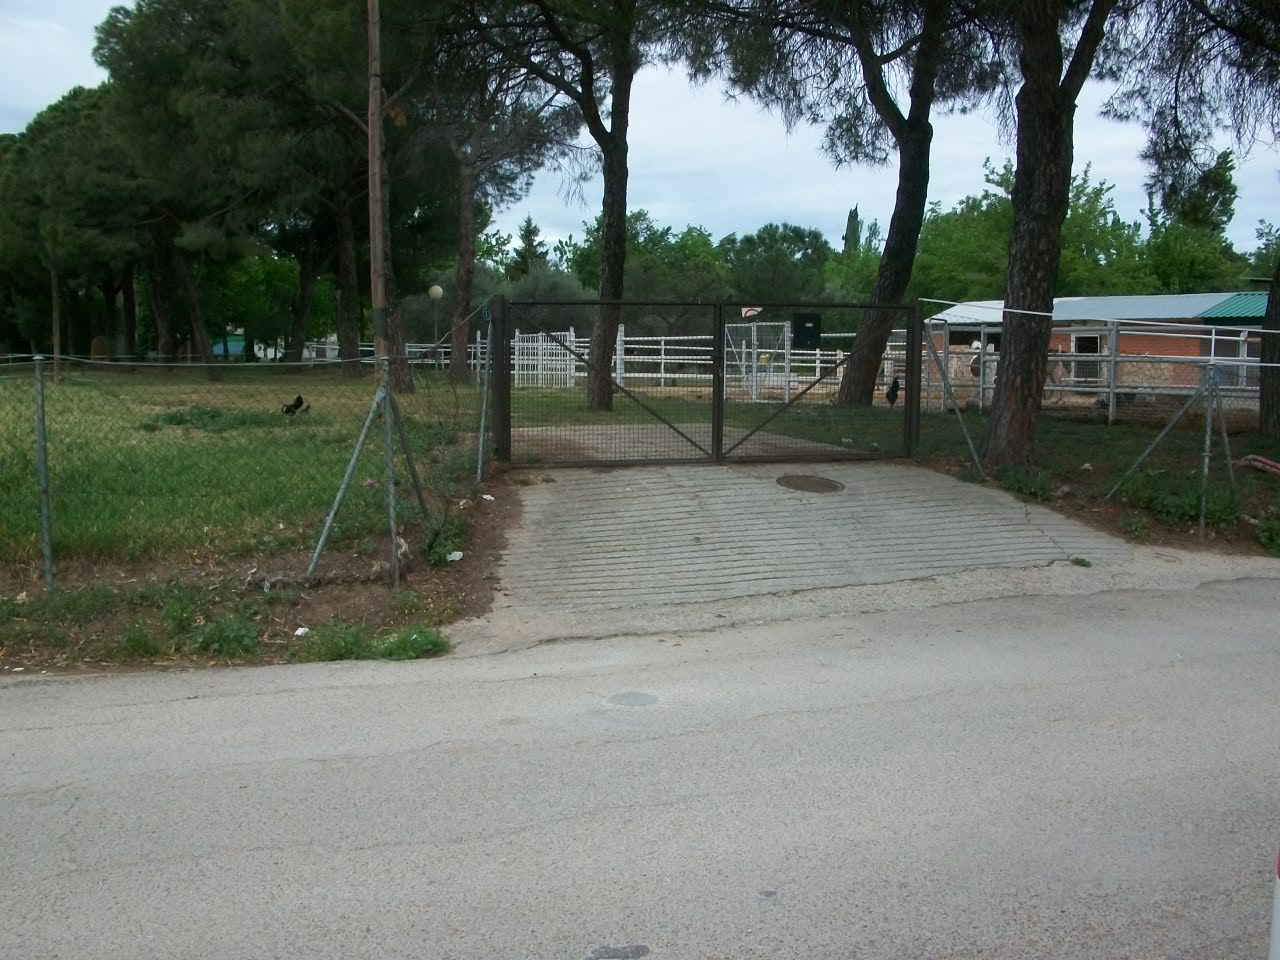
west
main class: Grassland
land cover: Grassland without tree/shrub cover
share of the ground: > 75 %
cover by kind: herbaceous plants 100 %
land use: Residential
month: May
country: ES
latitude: 40.1975
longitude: -3.8394
